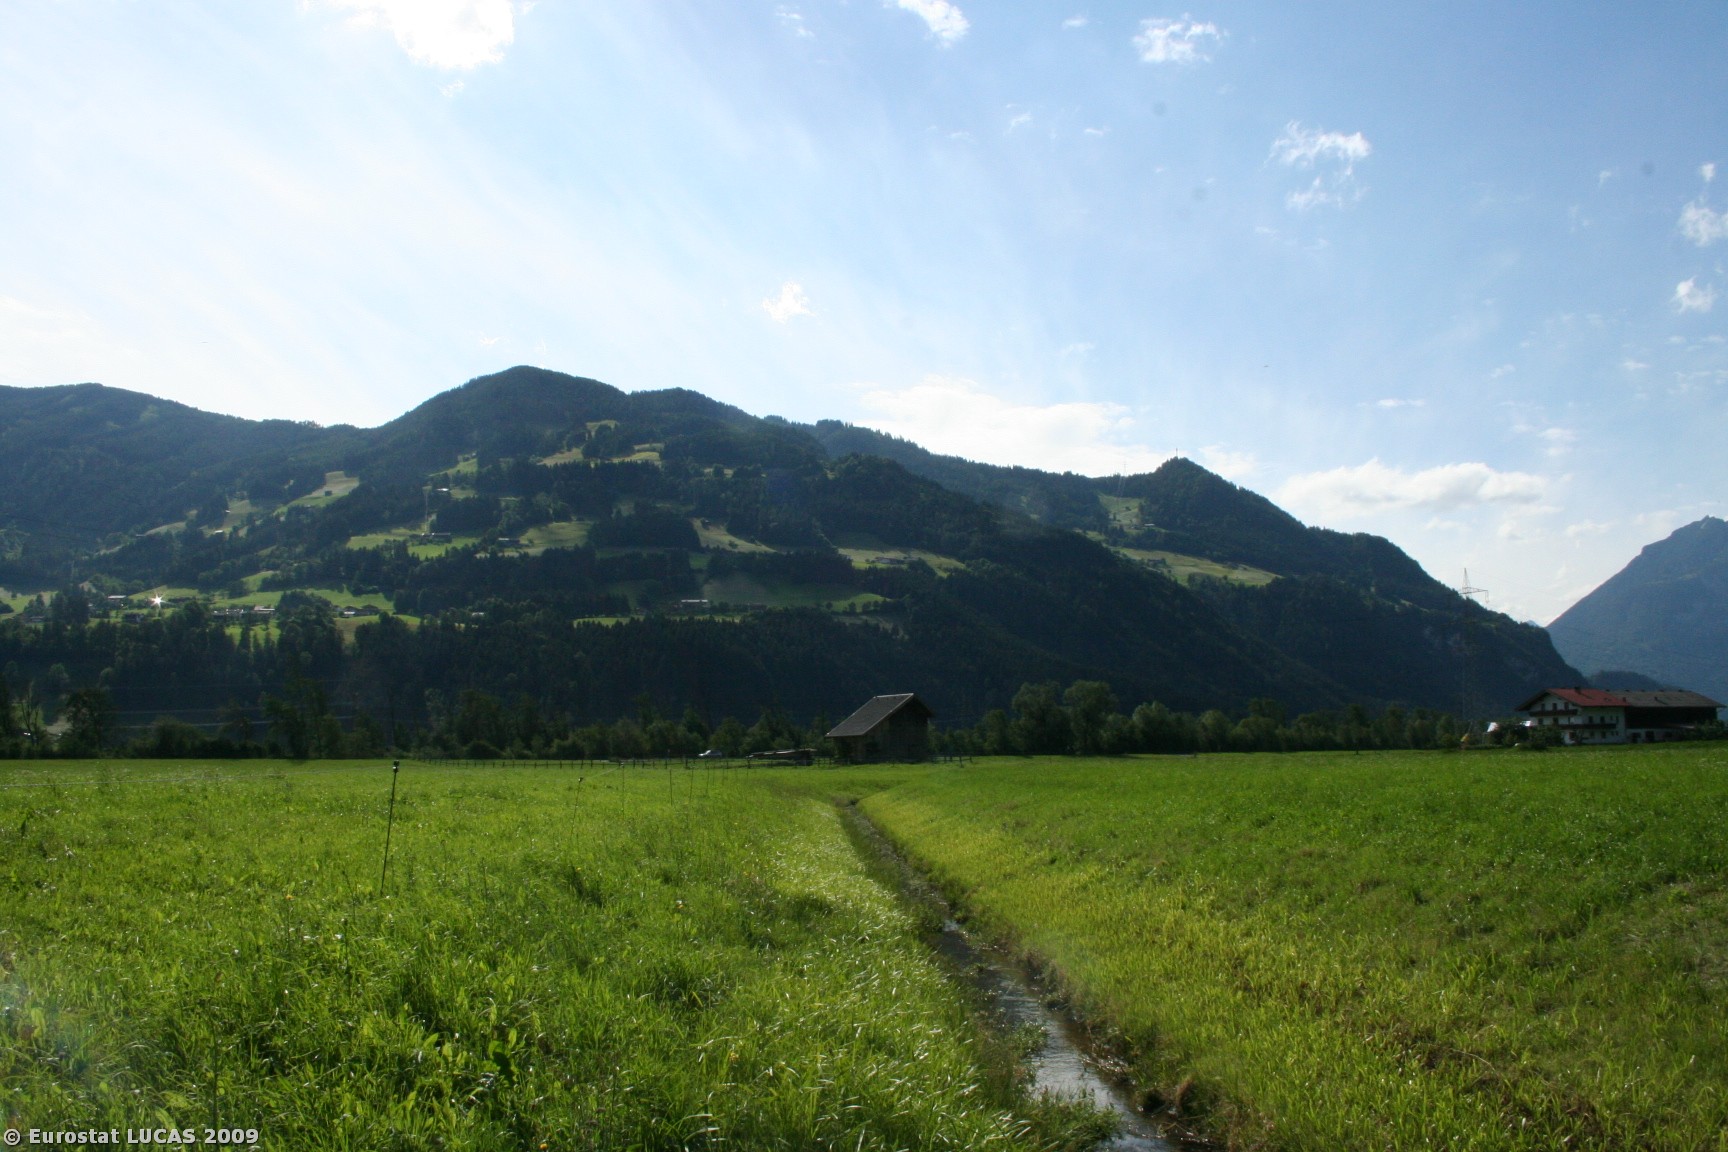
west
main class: Grassland
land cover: Grassland without tree/shrub cover
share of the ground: > 75 %
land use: Agriculture (excluding fallow land and kitchen gardens)
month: June
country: AT
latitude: 47.3616
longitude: 11.8654
